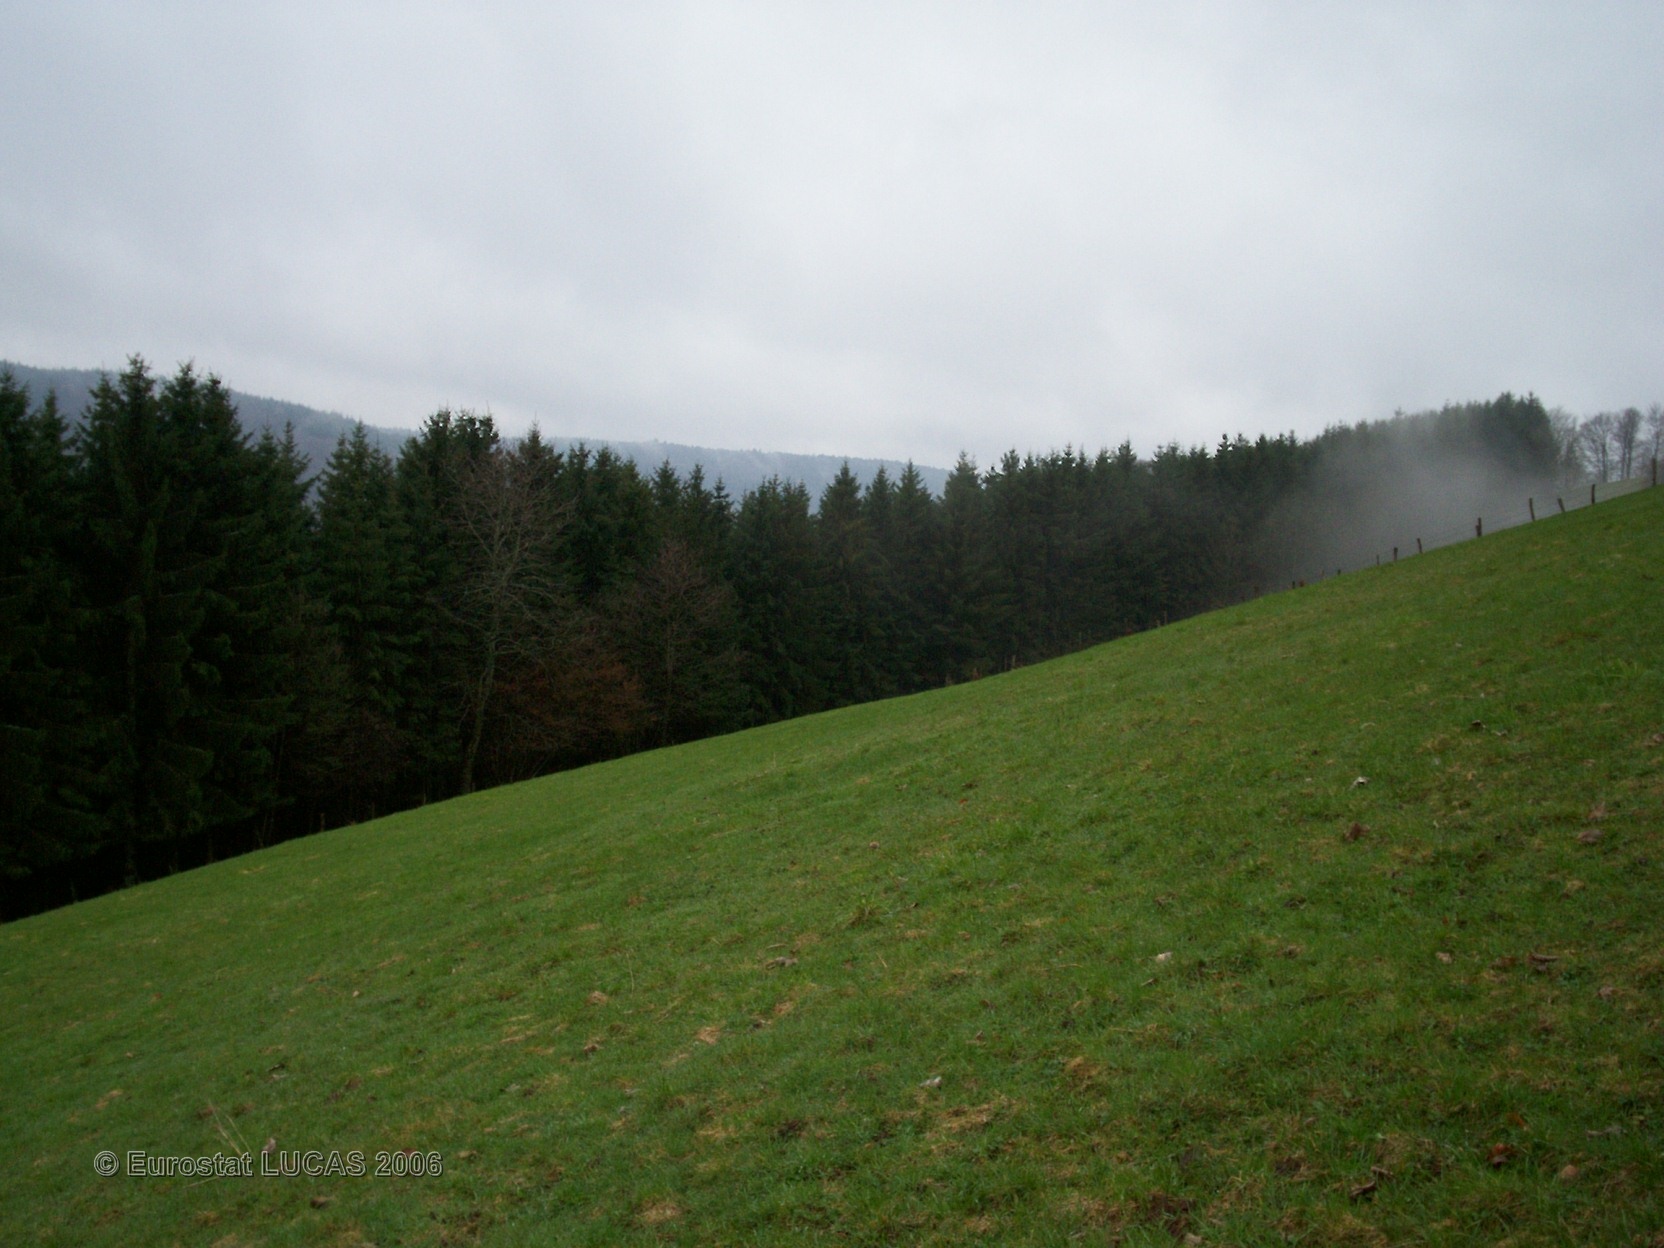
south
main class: Grassland
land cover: Grassland without tree/shrub cover
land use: Agriculture (excluding fallow land and kitchen gardens)
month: April
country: FR
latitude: 47.9358
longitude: 6.5609
